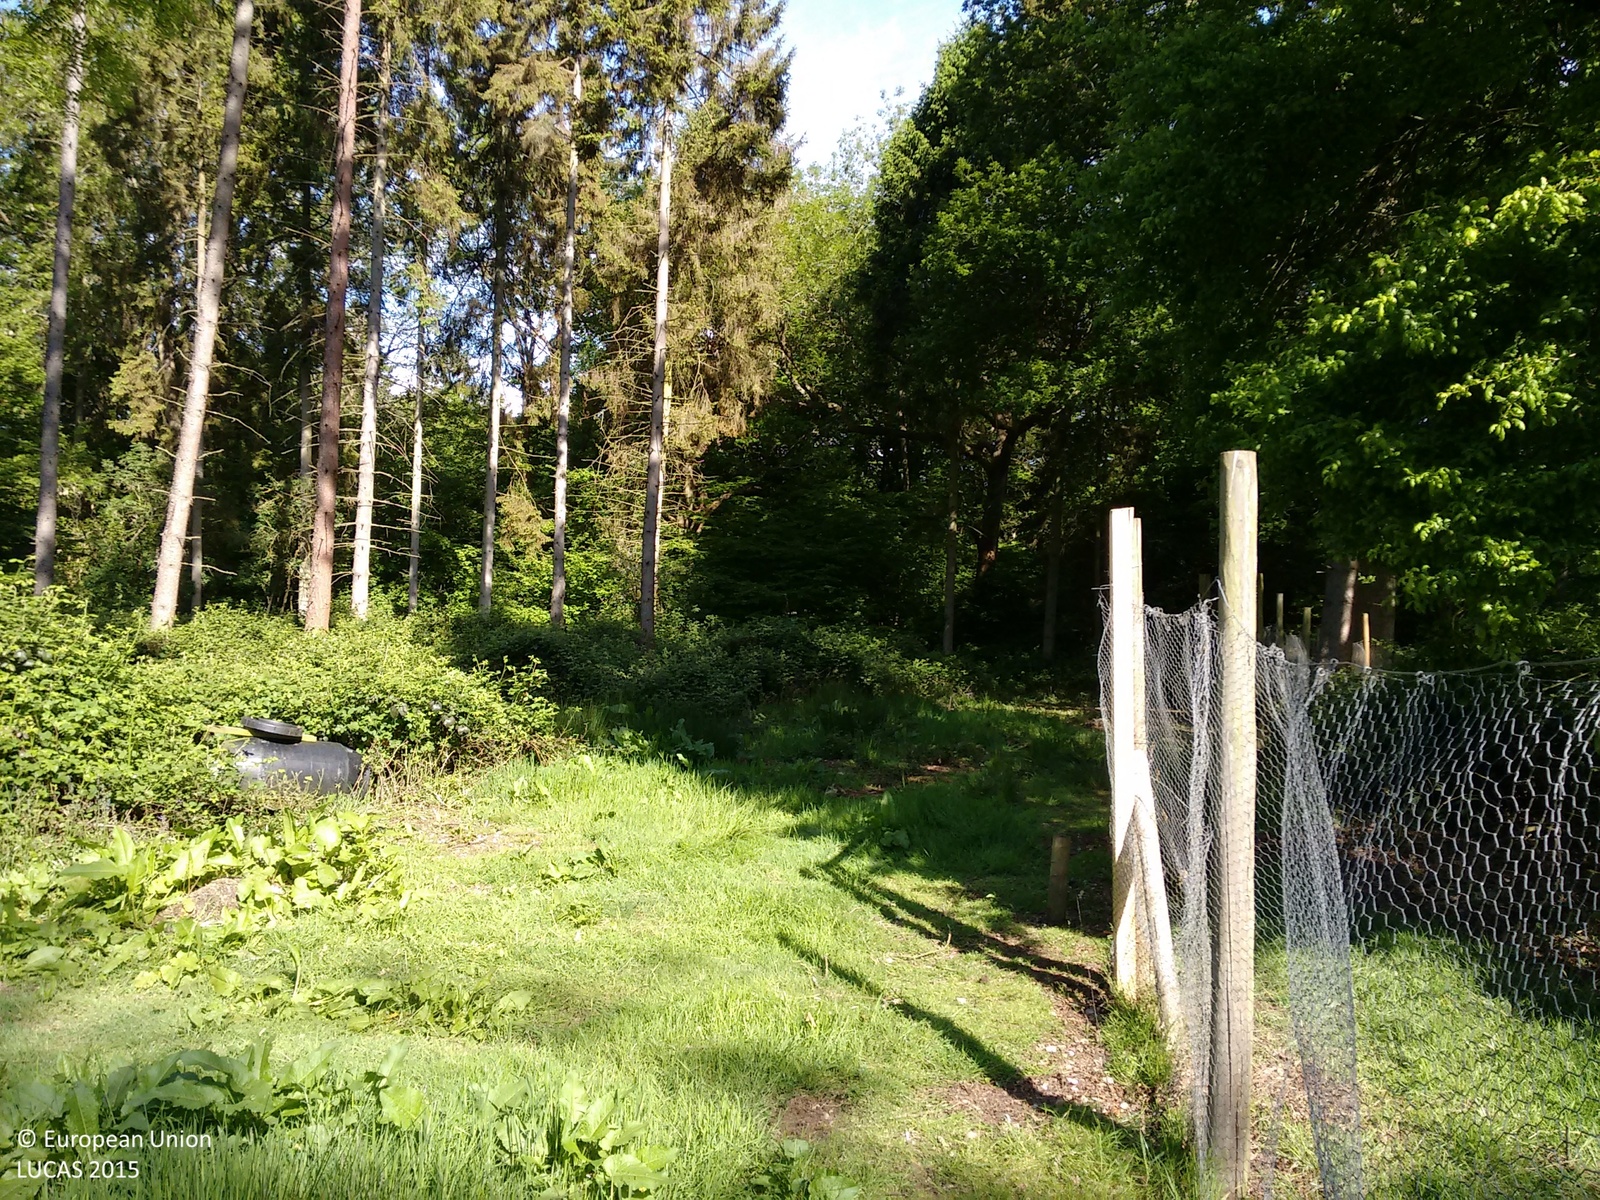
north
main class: Woodland
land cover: Other mixed woodland
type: hemiboreal forest and nemoral coniferous forest and mixed broadleaved-coniferous forest
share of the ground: > 75 %
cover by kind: broadleaved forest trees 60 %, coniferous forest trees 30 %, herbaceous plants 10 %
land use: Forestry
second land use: Agriculture (excluding fallow land and kitchen gardens)
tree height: > 5 m
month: May
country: GB
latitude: 51.8937
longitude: -0.2804
